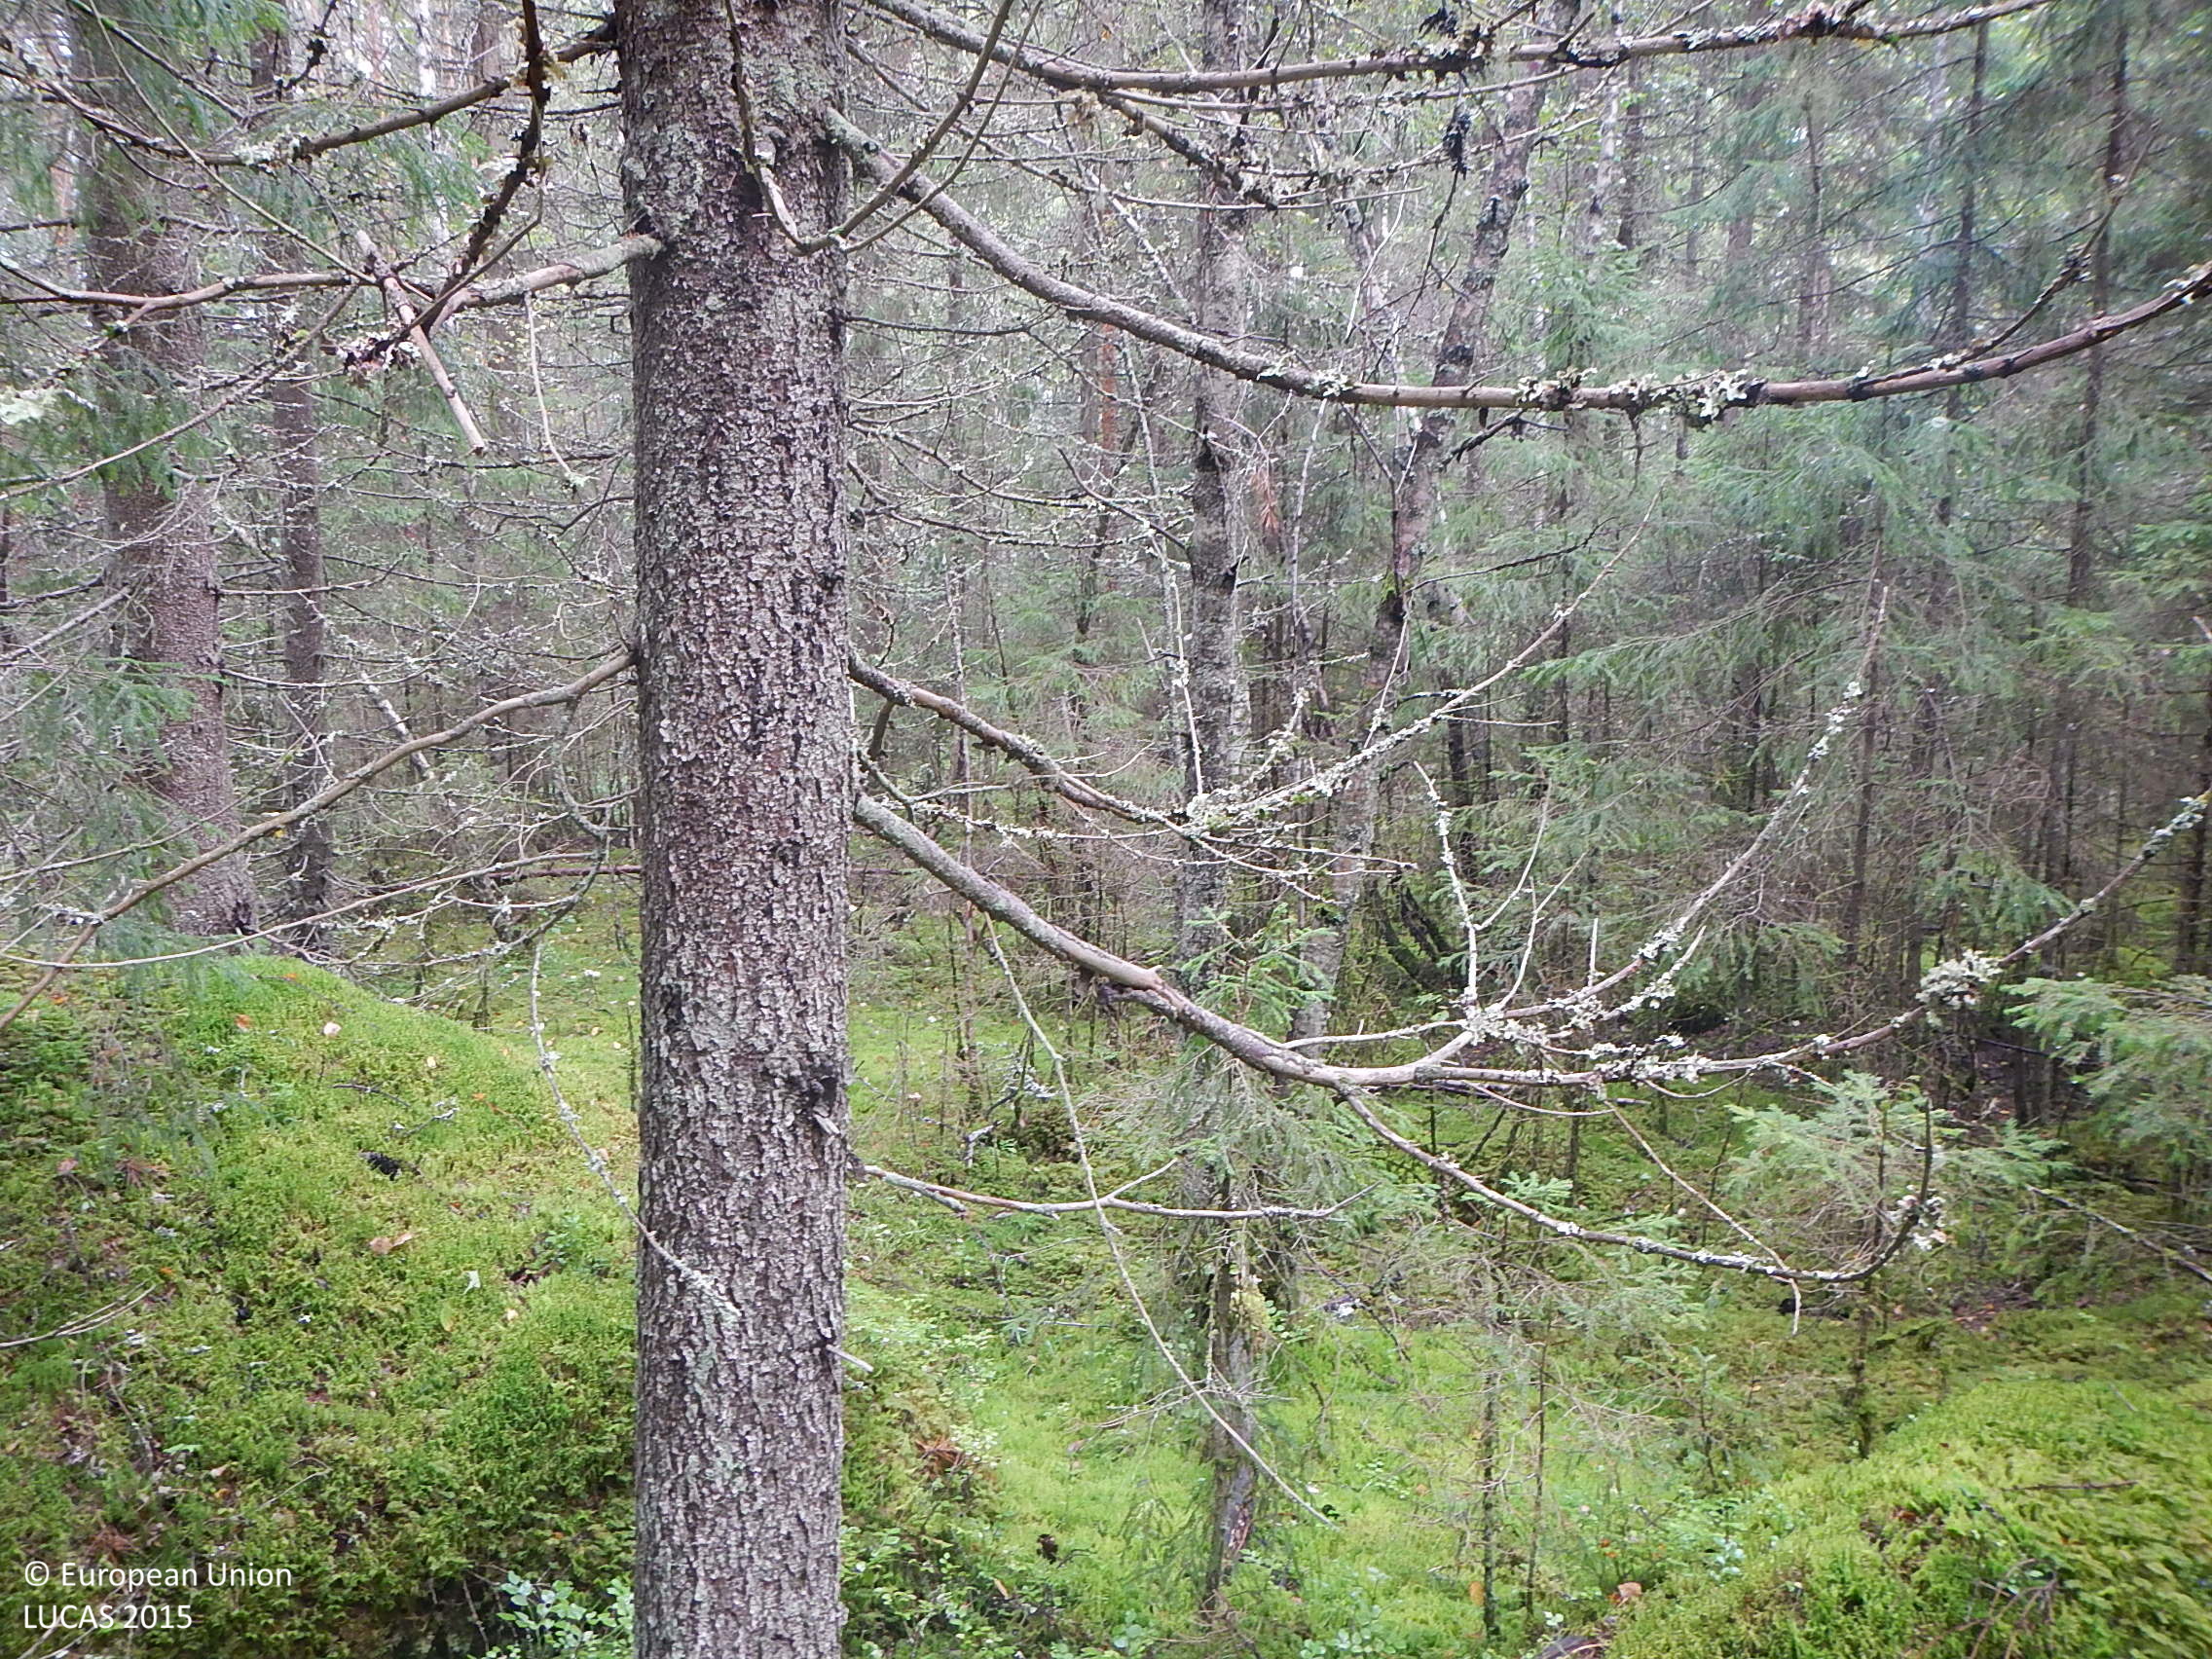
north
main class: Woodland
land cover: Spruce dominated mixed woodland
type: boreal forest
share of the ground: > 75 %
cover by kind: coniferous forest trees 50 %, broadleaved forest trees 25 %, lichens and mosses 20 %, shrubs 5 %
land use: Forestry
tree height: > 5 m
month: September
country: FI
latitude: 61.4886
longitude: 23.0870
